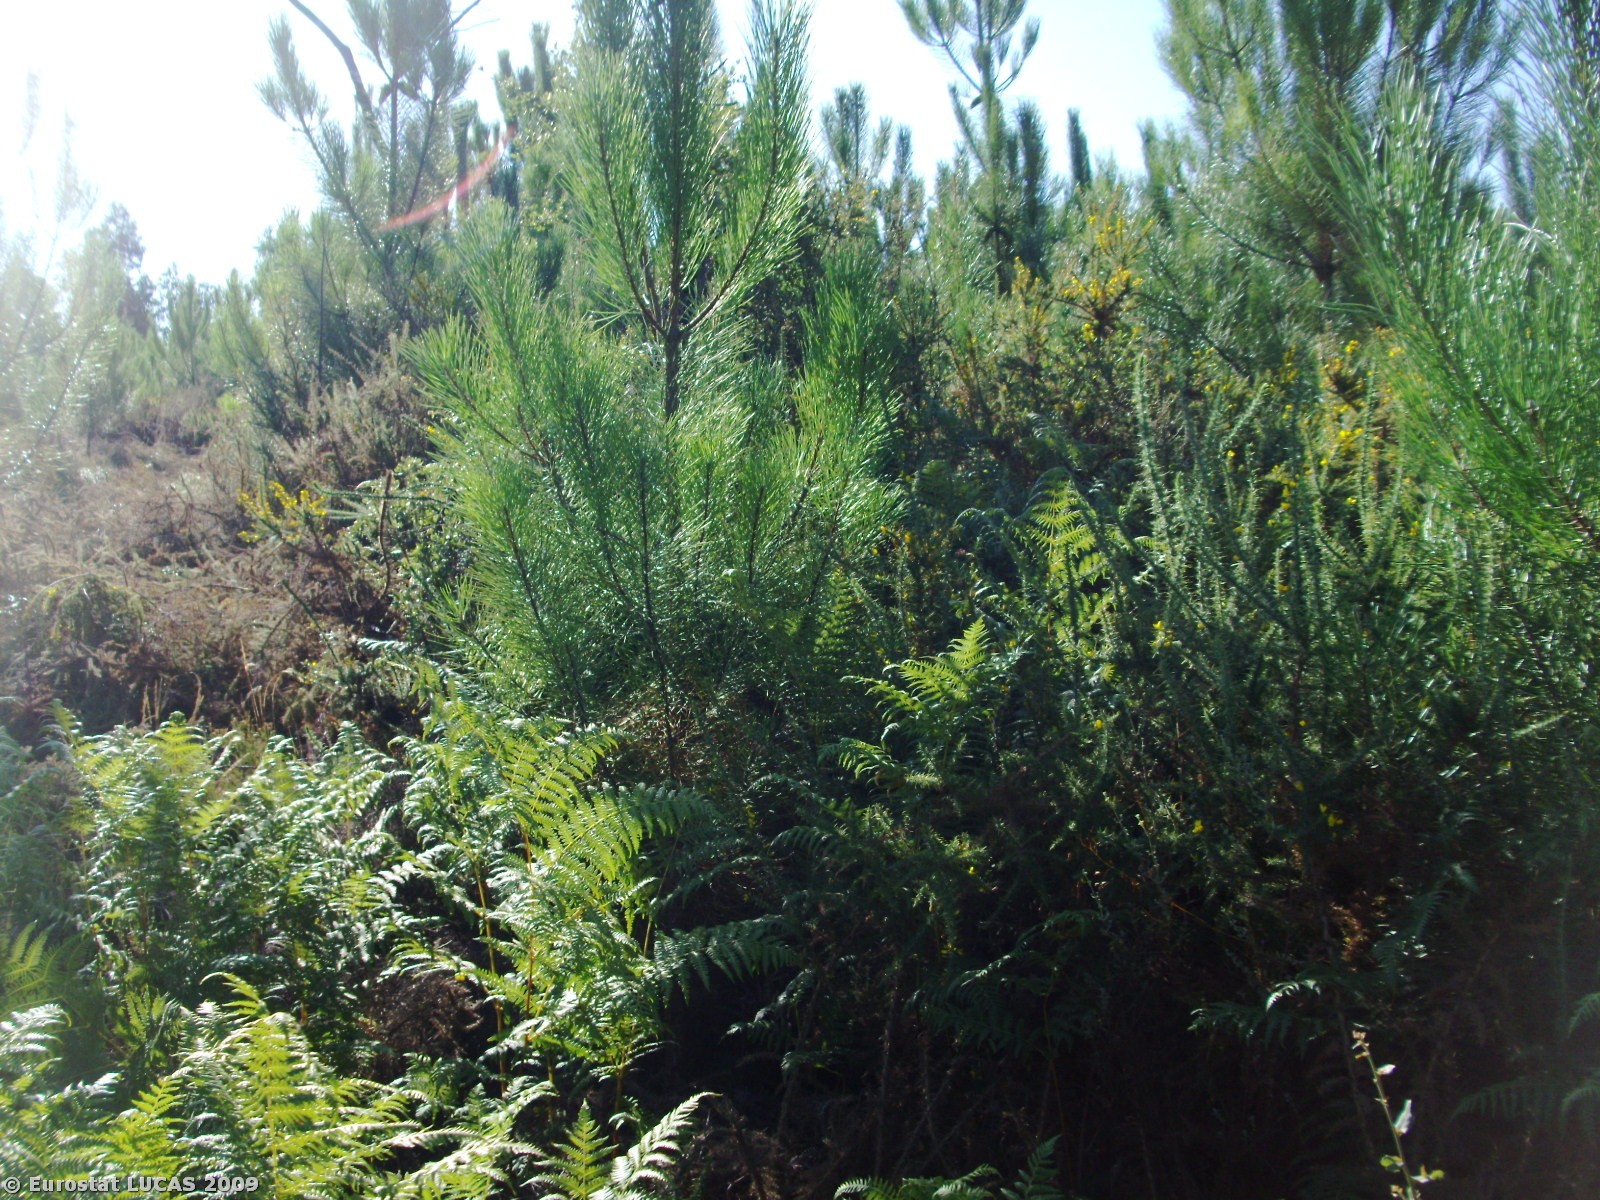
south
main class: Woodland
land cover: Mixed woodland
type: coniferous forest of the mediterranean region
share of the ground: > 75 %
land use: Forestry
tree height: > 5 m
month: August
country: PT
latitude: 39.8390
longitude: -8.1233
